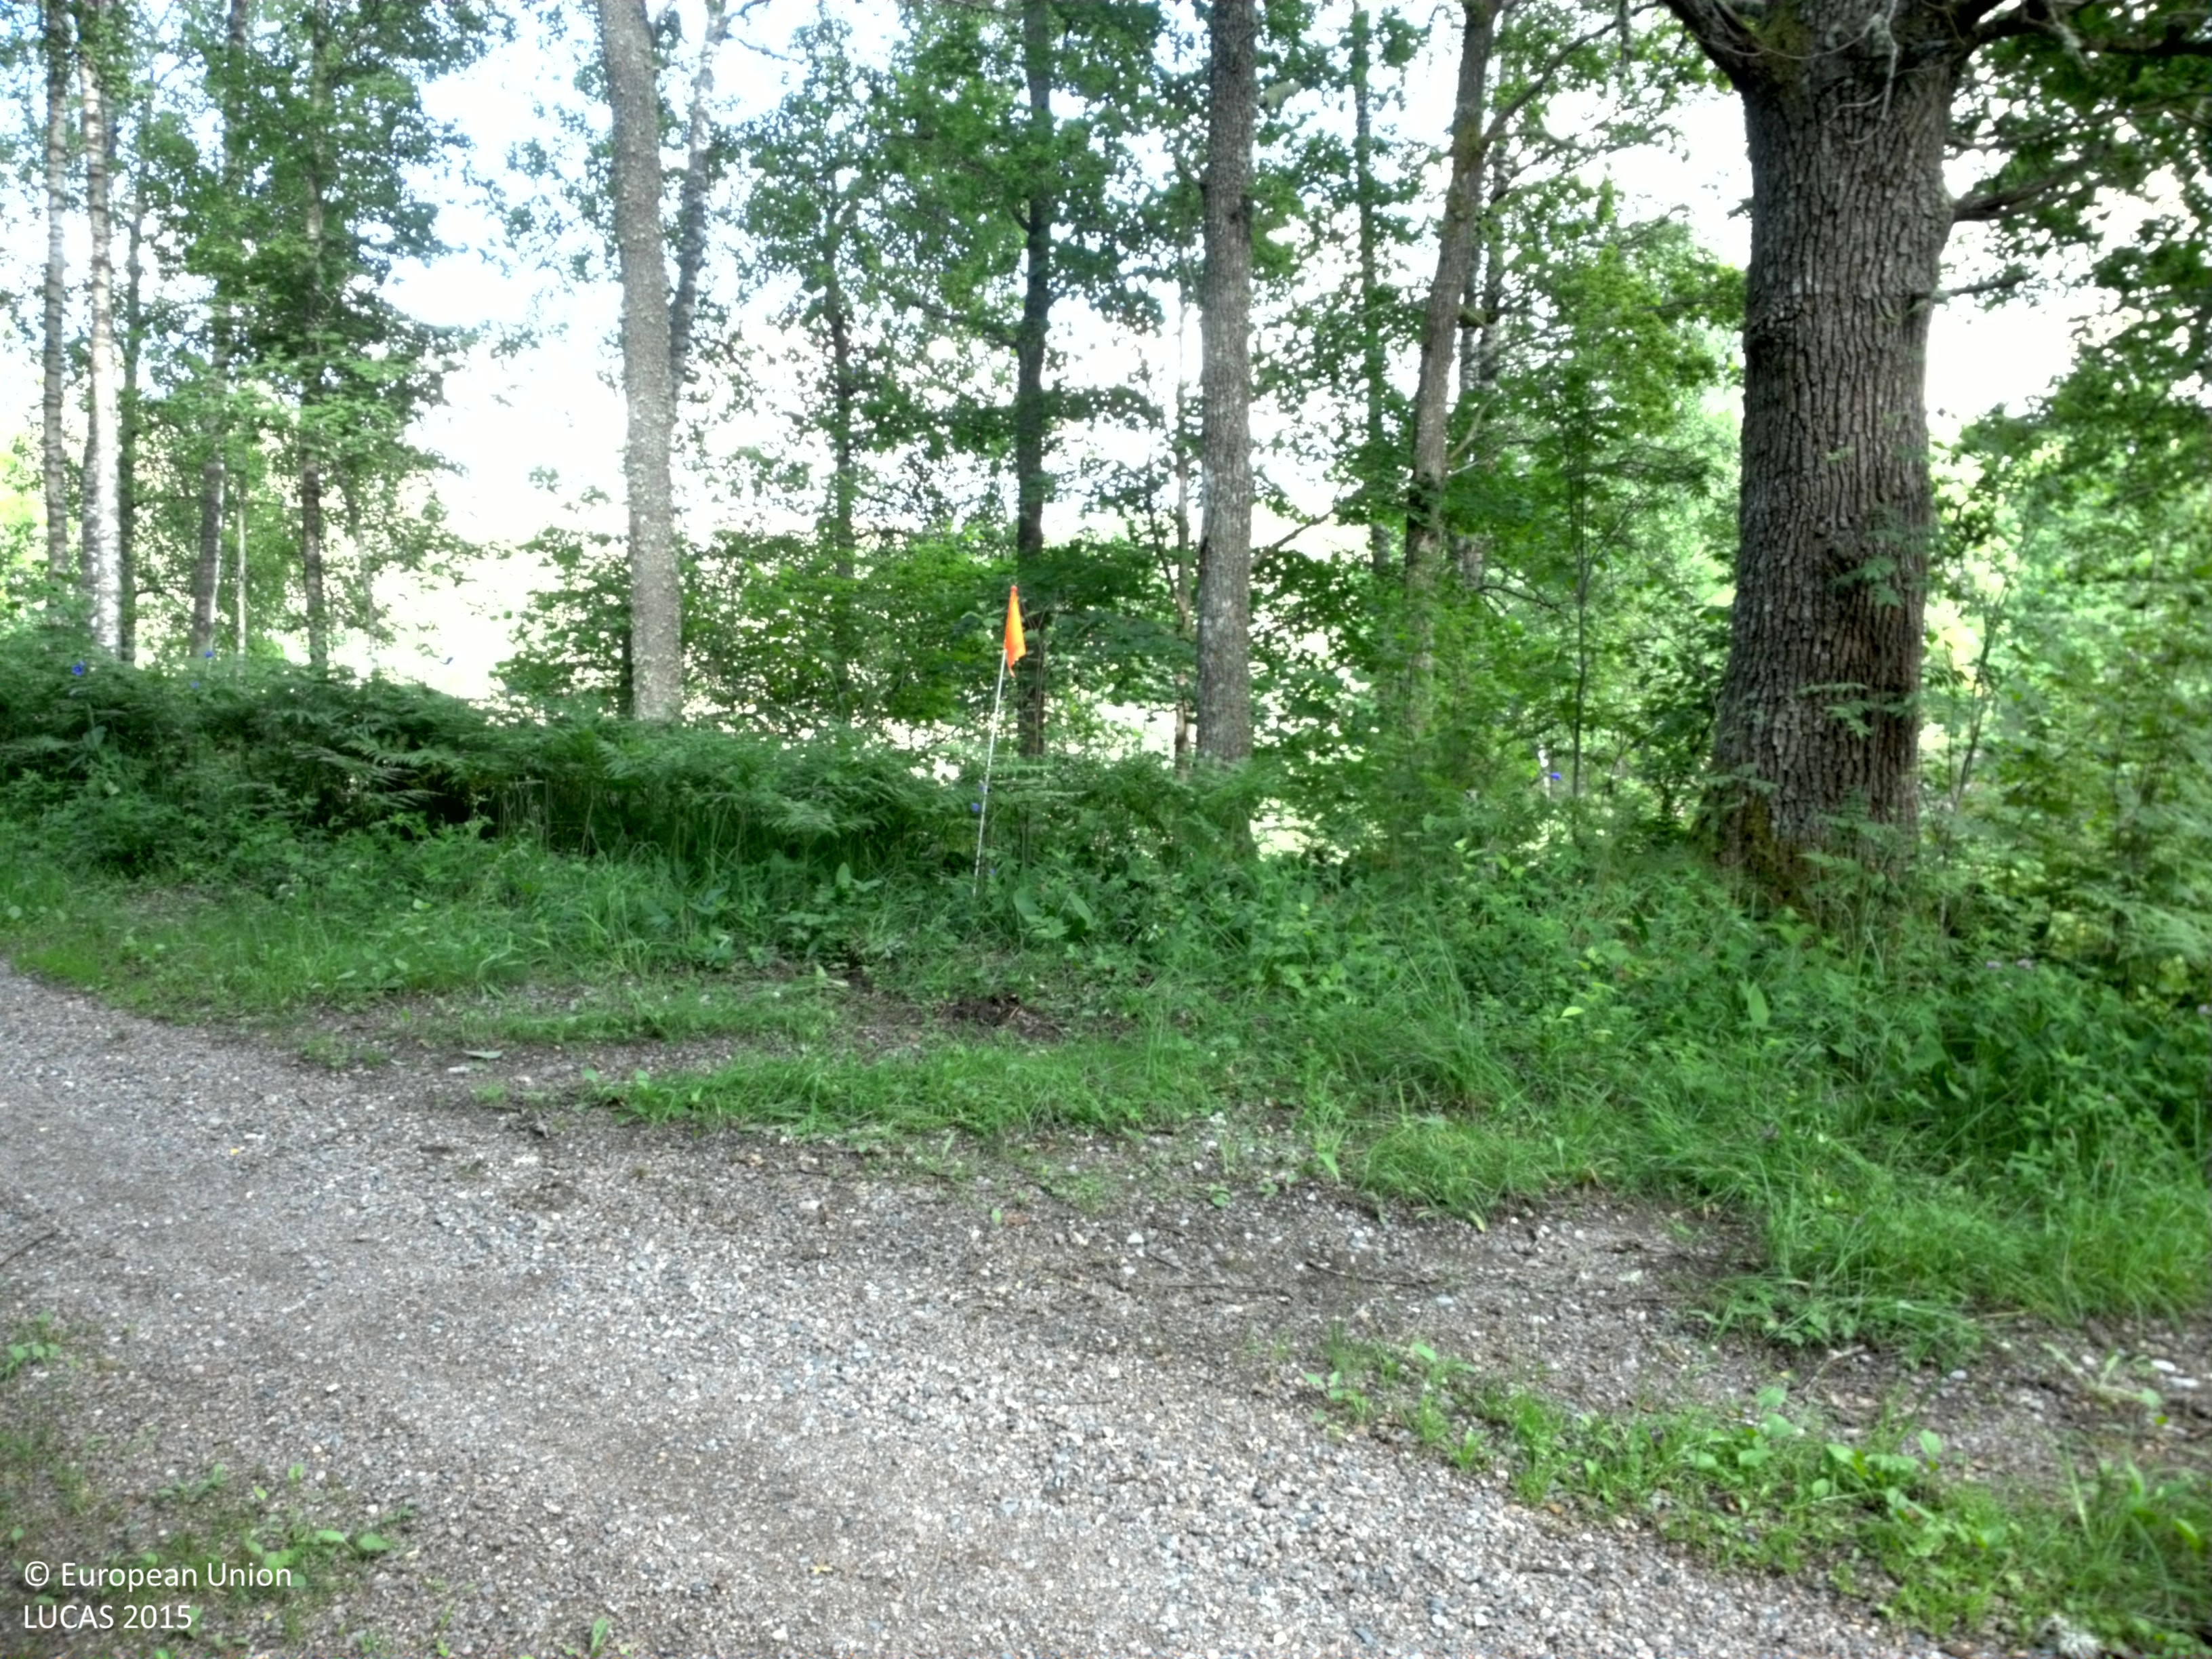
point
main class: Woodland
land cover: Broadleaved woodland
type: hemiboreal forest and nemoral coniferous forest and mixed broadleaved-coniferous forest
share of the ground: 50 - 75 %
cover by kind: broadleaved forest trees 60 %, herbaceous plants 40 %
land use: Forestry
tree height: > 5 m
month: July
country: SE
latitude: 58.7587
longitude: 15.4386
